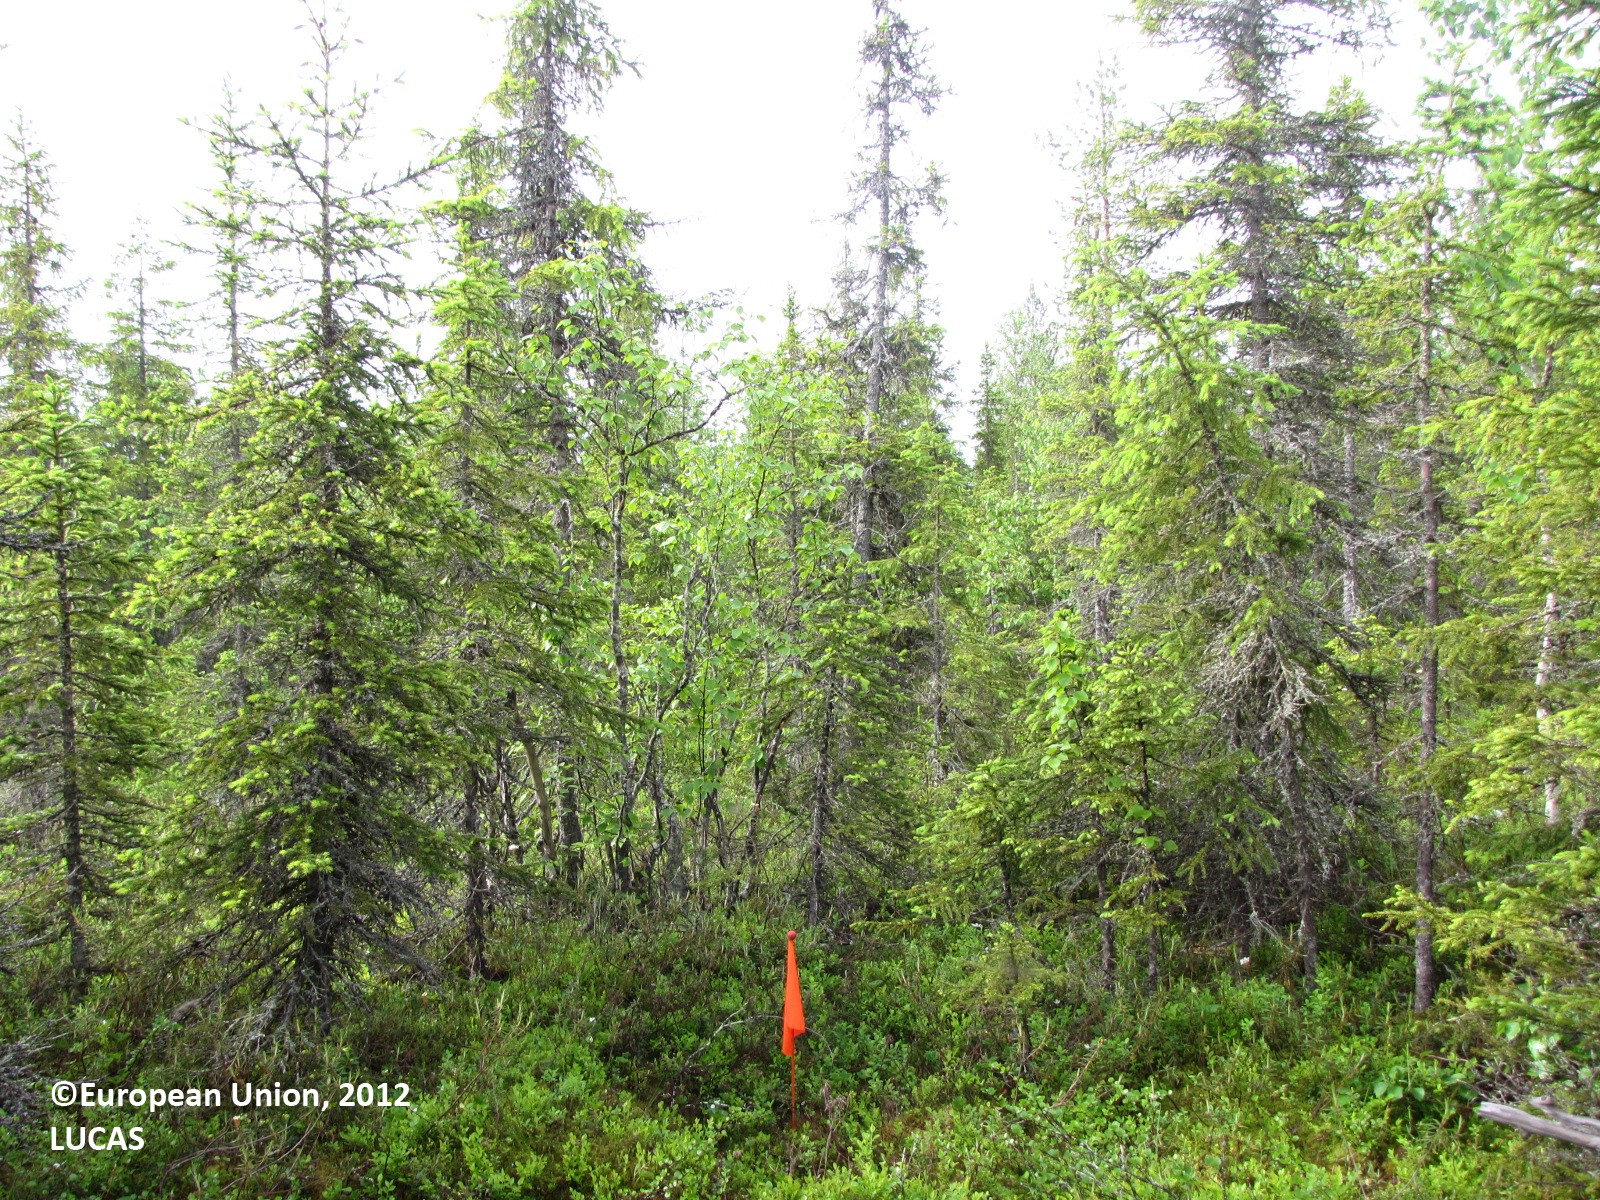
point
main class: Woodland
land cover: Spruce dominated mixed woodland
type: boreal forest
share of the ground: 50 - 75 %
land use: Forestry
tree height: > 5 m
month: June
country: FI
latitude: 66.2158
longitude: 24.7409
